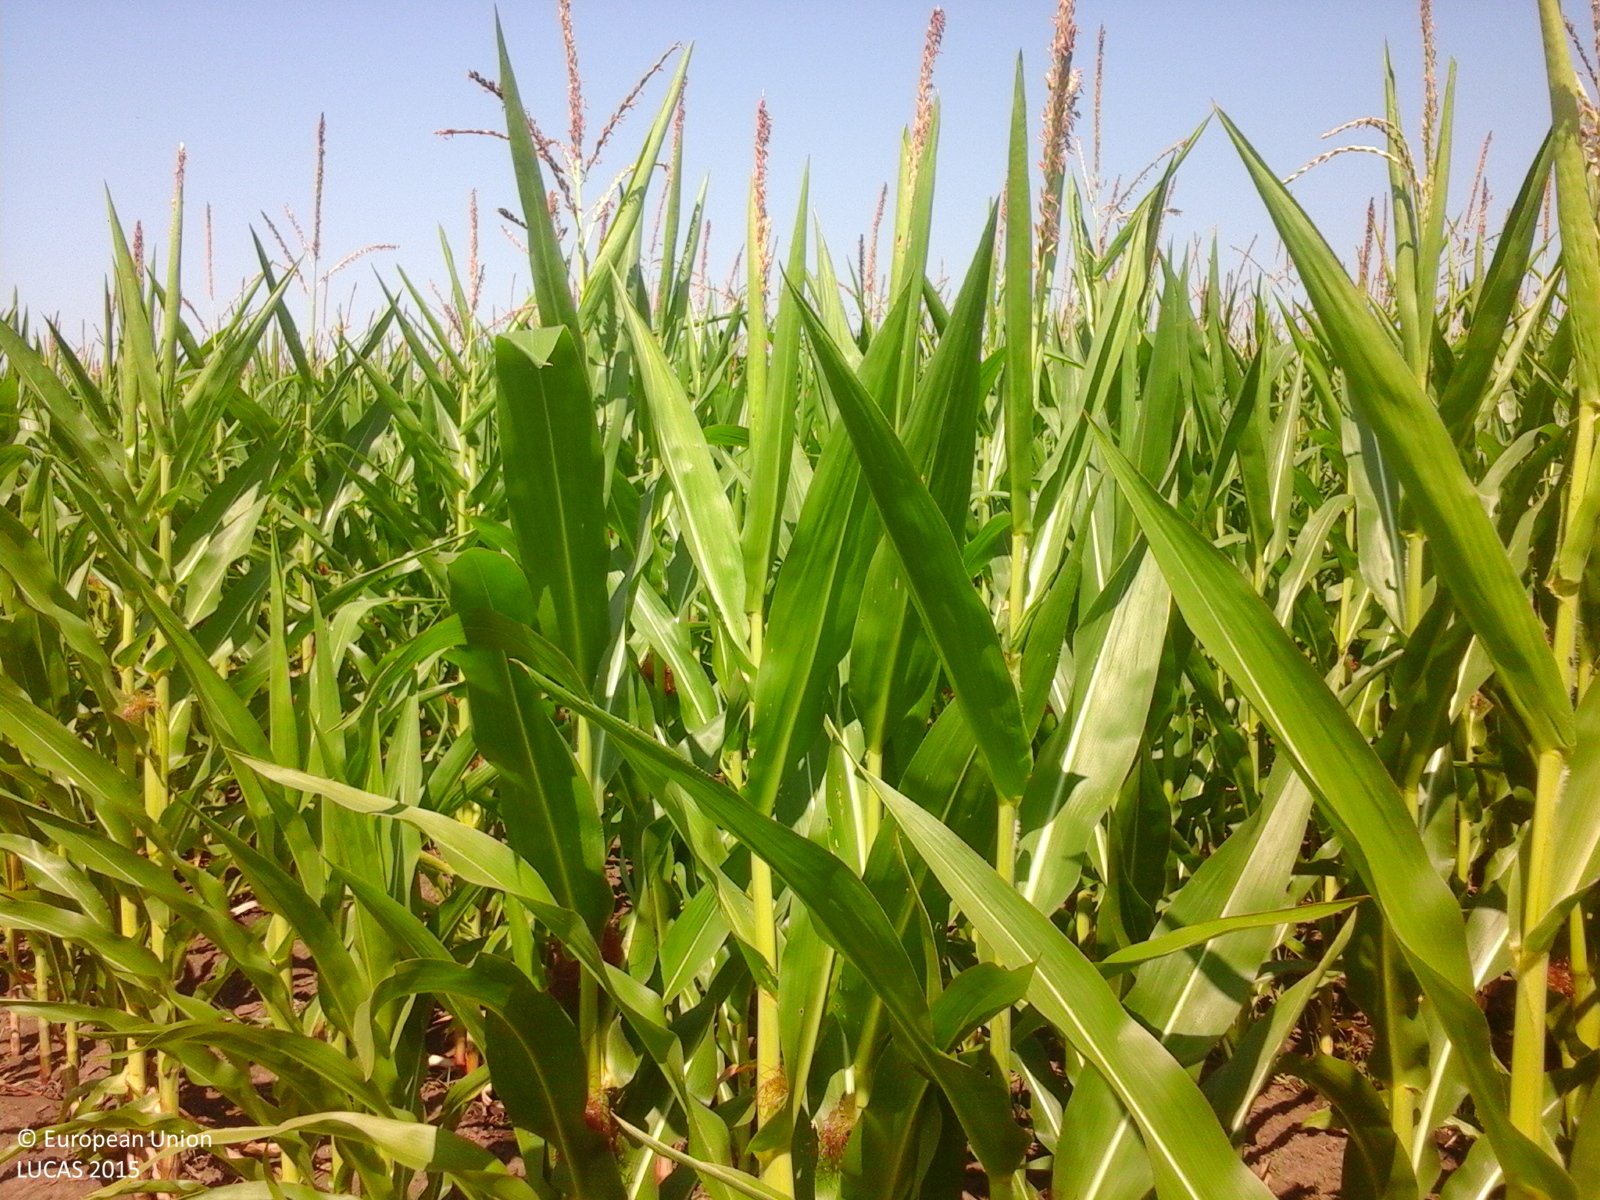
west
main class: Cropland
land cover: Maize
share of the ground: > 75 %
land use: Agriculture (excluding fallow land and kitchen gardens)
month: July
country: RO
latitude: 43.8943
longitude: 24.7473
